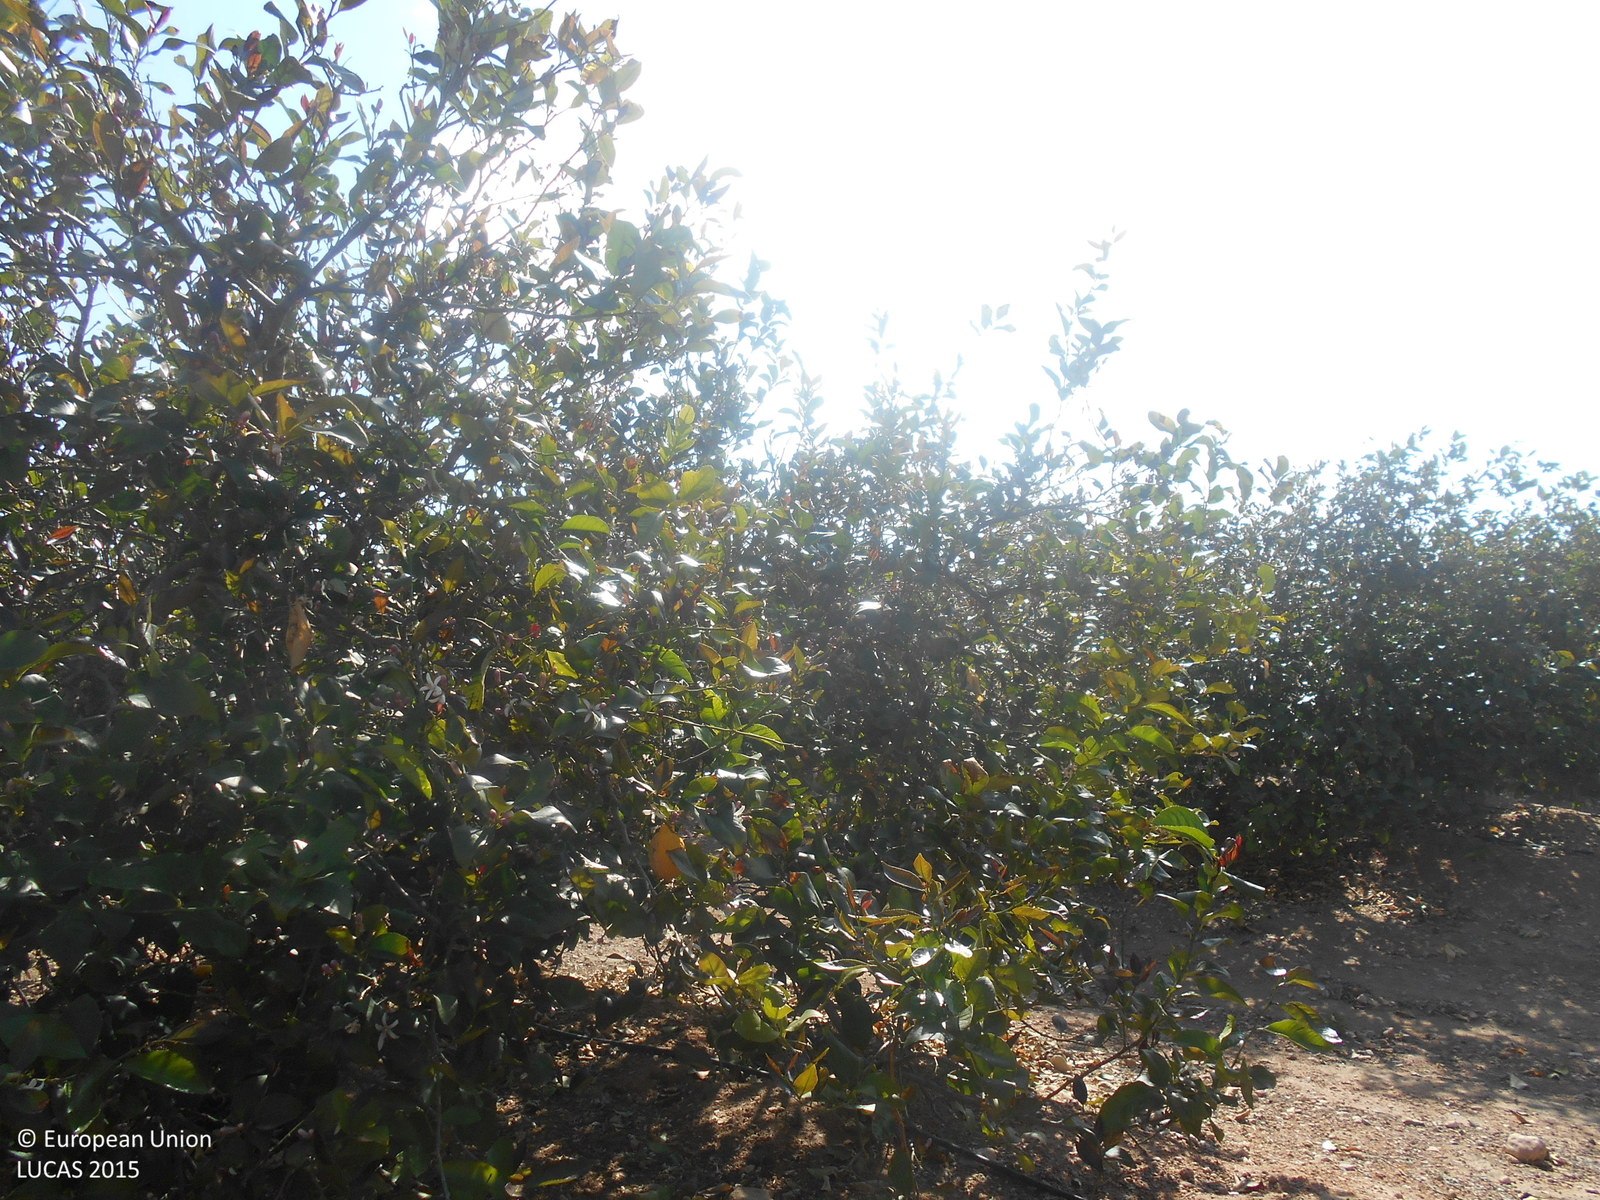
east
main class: Cropland
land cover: Other citrus fruit
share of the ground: 50 - 75 %
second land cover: Other bare soil
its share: > 75 %
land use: Agriculture (excluding fallow land and kitchen gardens)
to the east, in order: Other citrus fruit; Other bare soil; Tracks; Other citrus fruit; Tracks; Shruby margins; Tracks
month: April
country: ES
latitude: 37.7795
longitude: -1.3476
